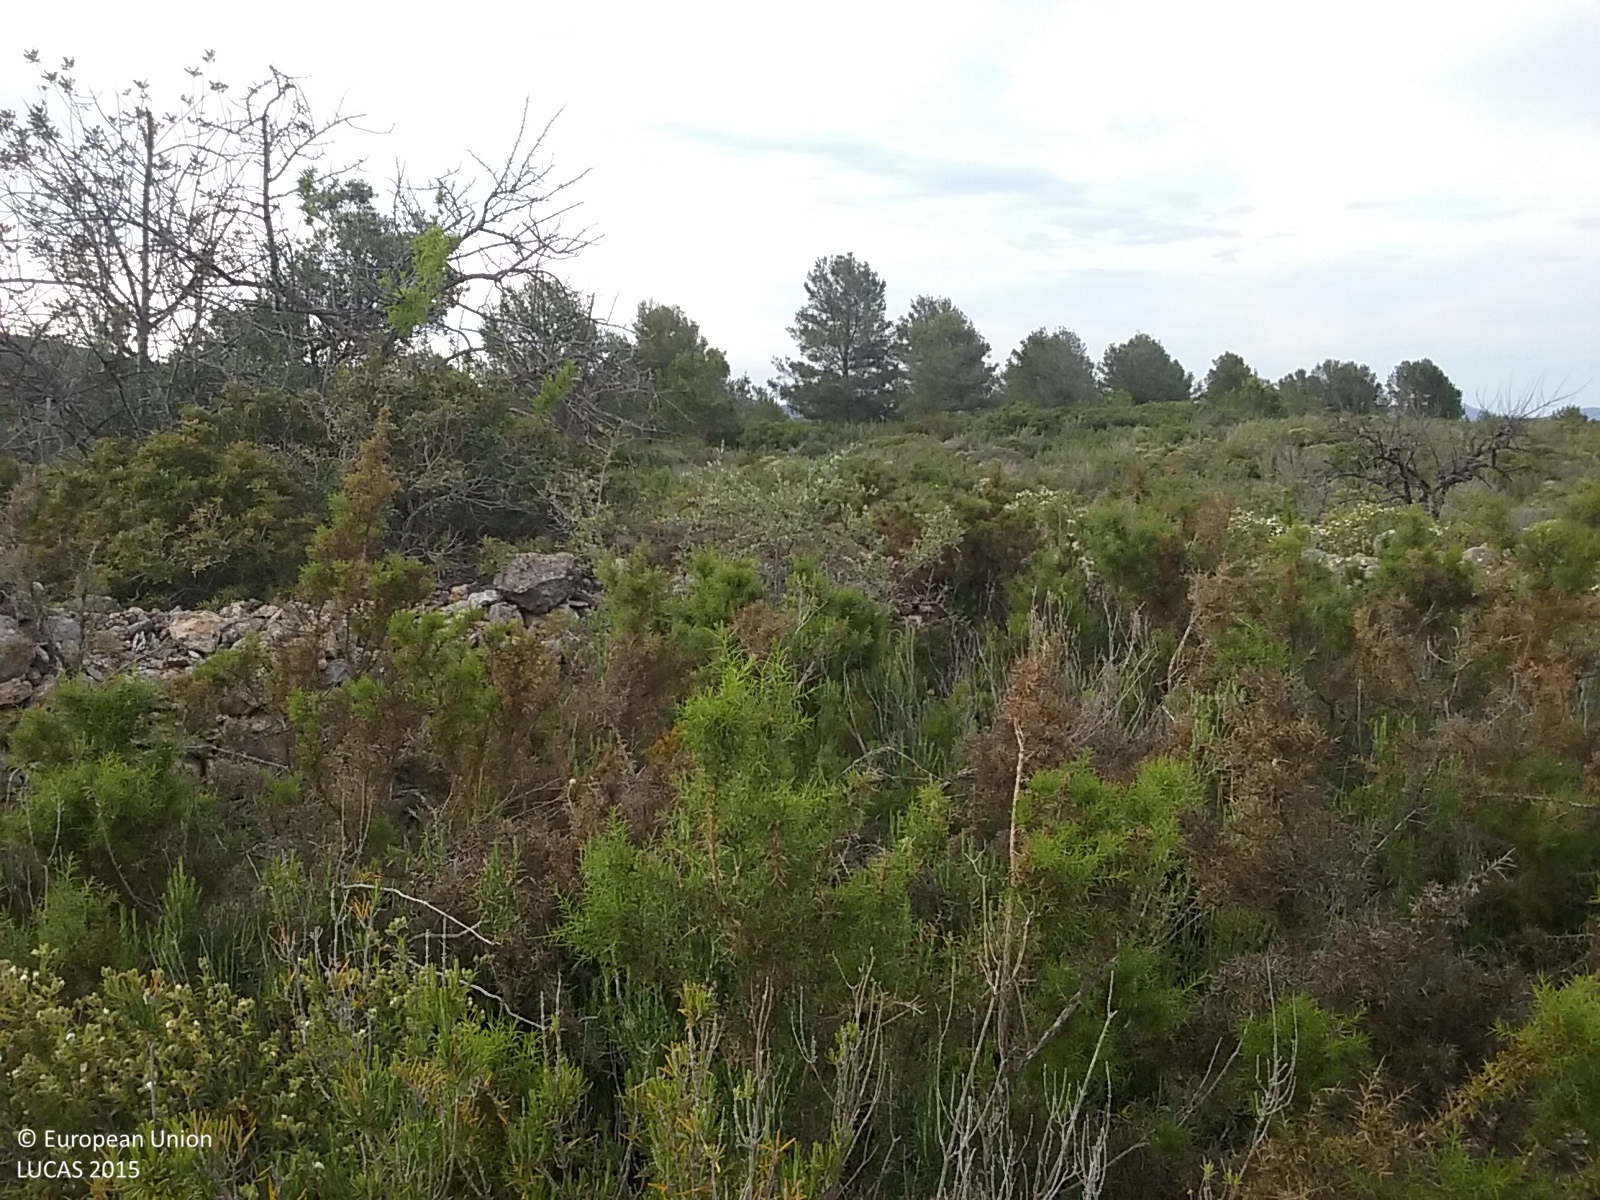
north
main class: Shrubland
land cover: Shrubland with sparse tree cover
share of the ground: 50 - 75 %
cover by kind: shrubs 70 %, unconsolidated bare surface 25 %, broadleaved forest trees 5 %
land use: Abandoned areas
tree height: < 5 m
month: May
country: ES
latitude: 40.2222
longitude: 0.1144
